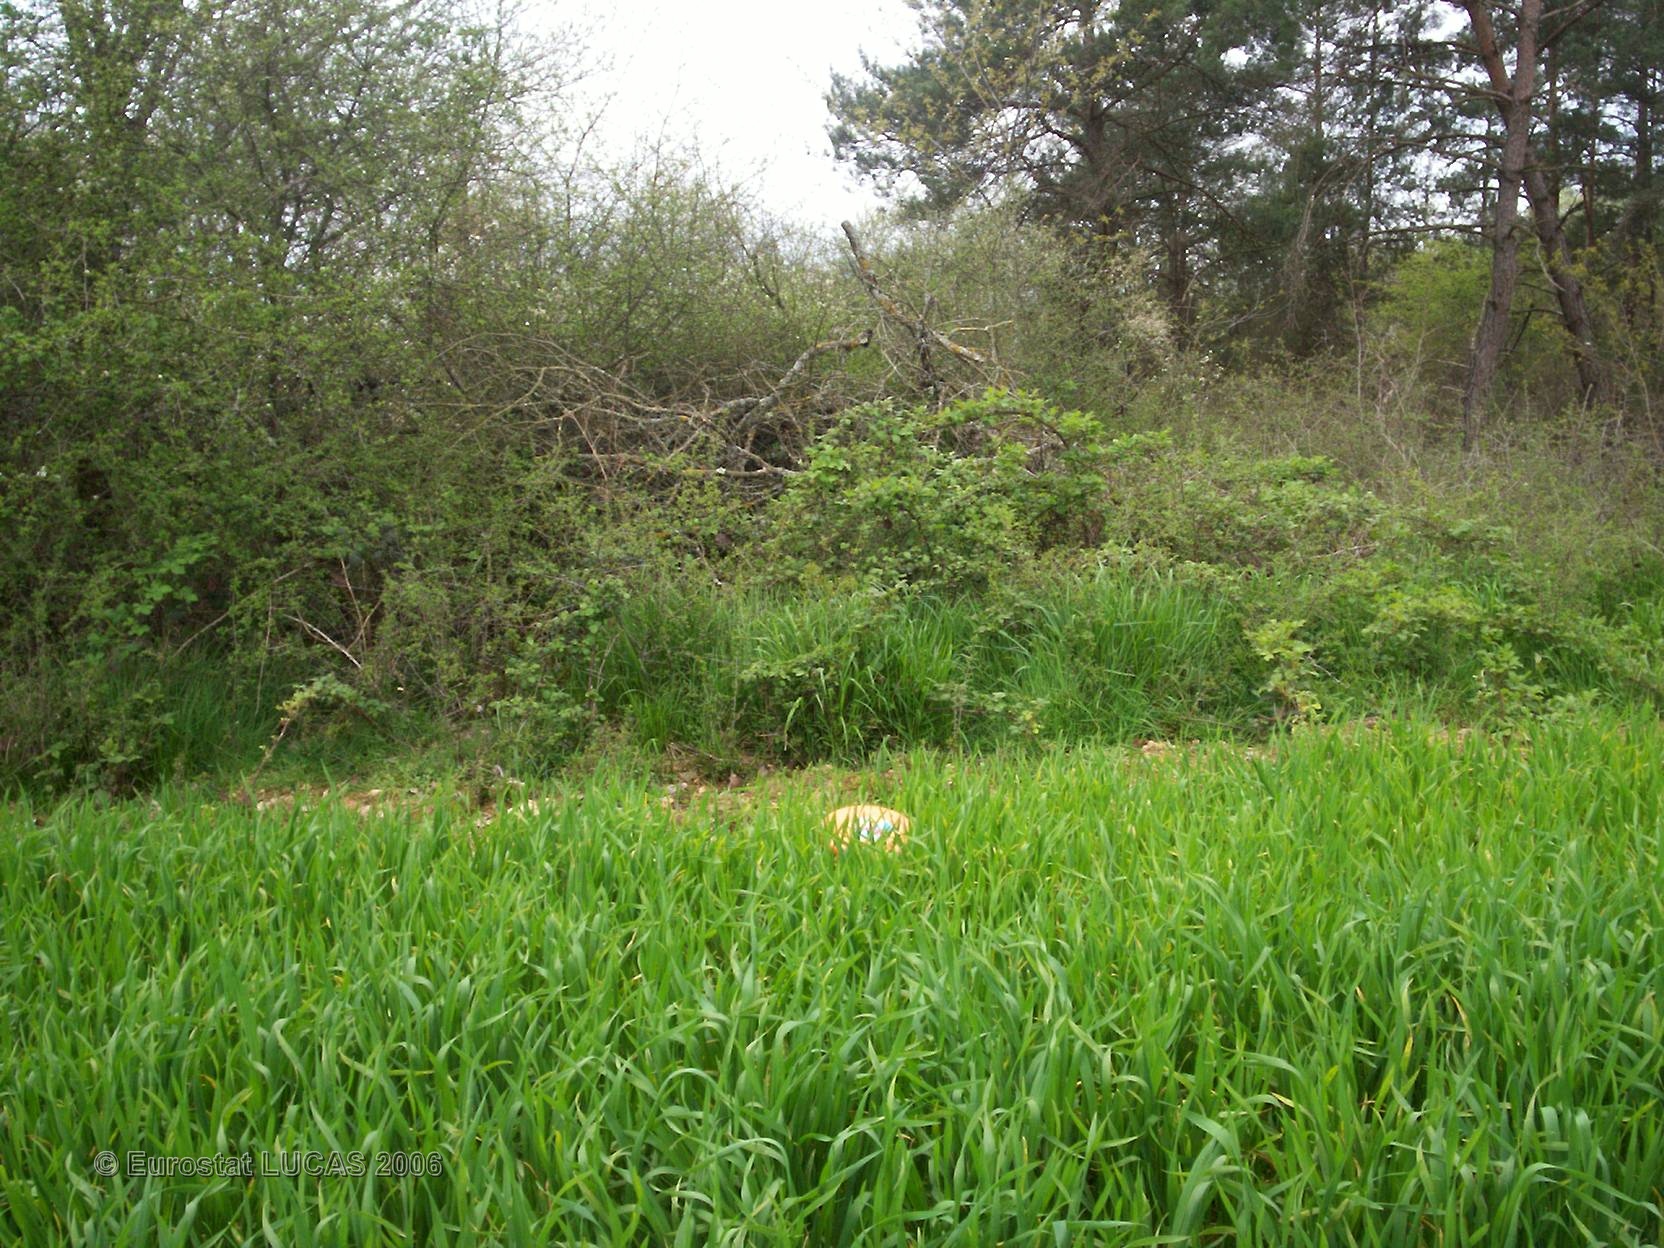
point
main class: Cropland
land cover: Common wheat
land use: Agriculture (excluding fallow land and kitchen gardens)
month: April
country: FR
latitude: 46.1780
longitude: 0.4624
